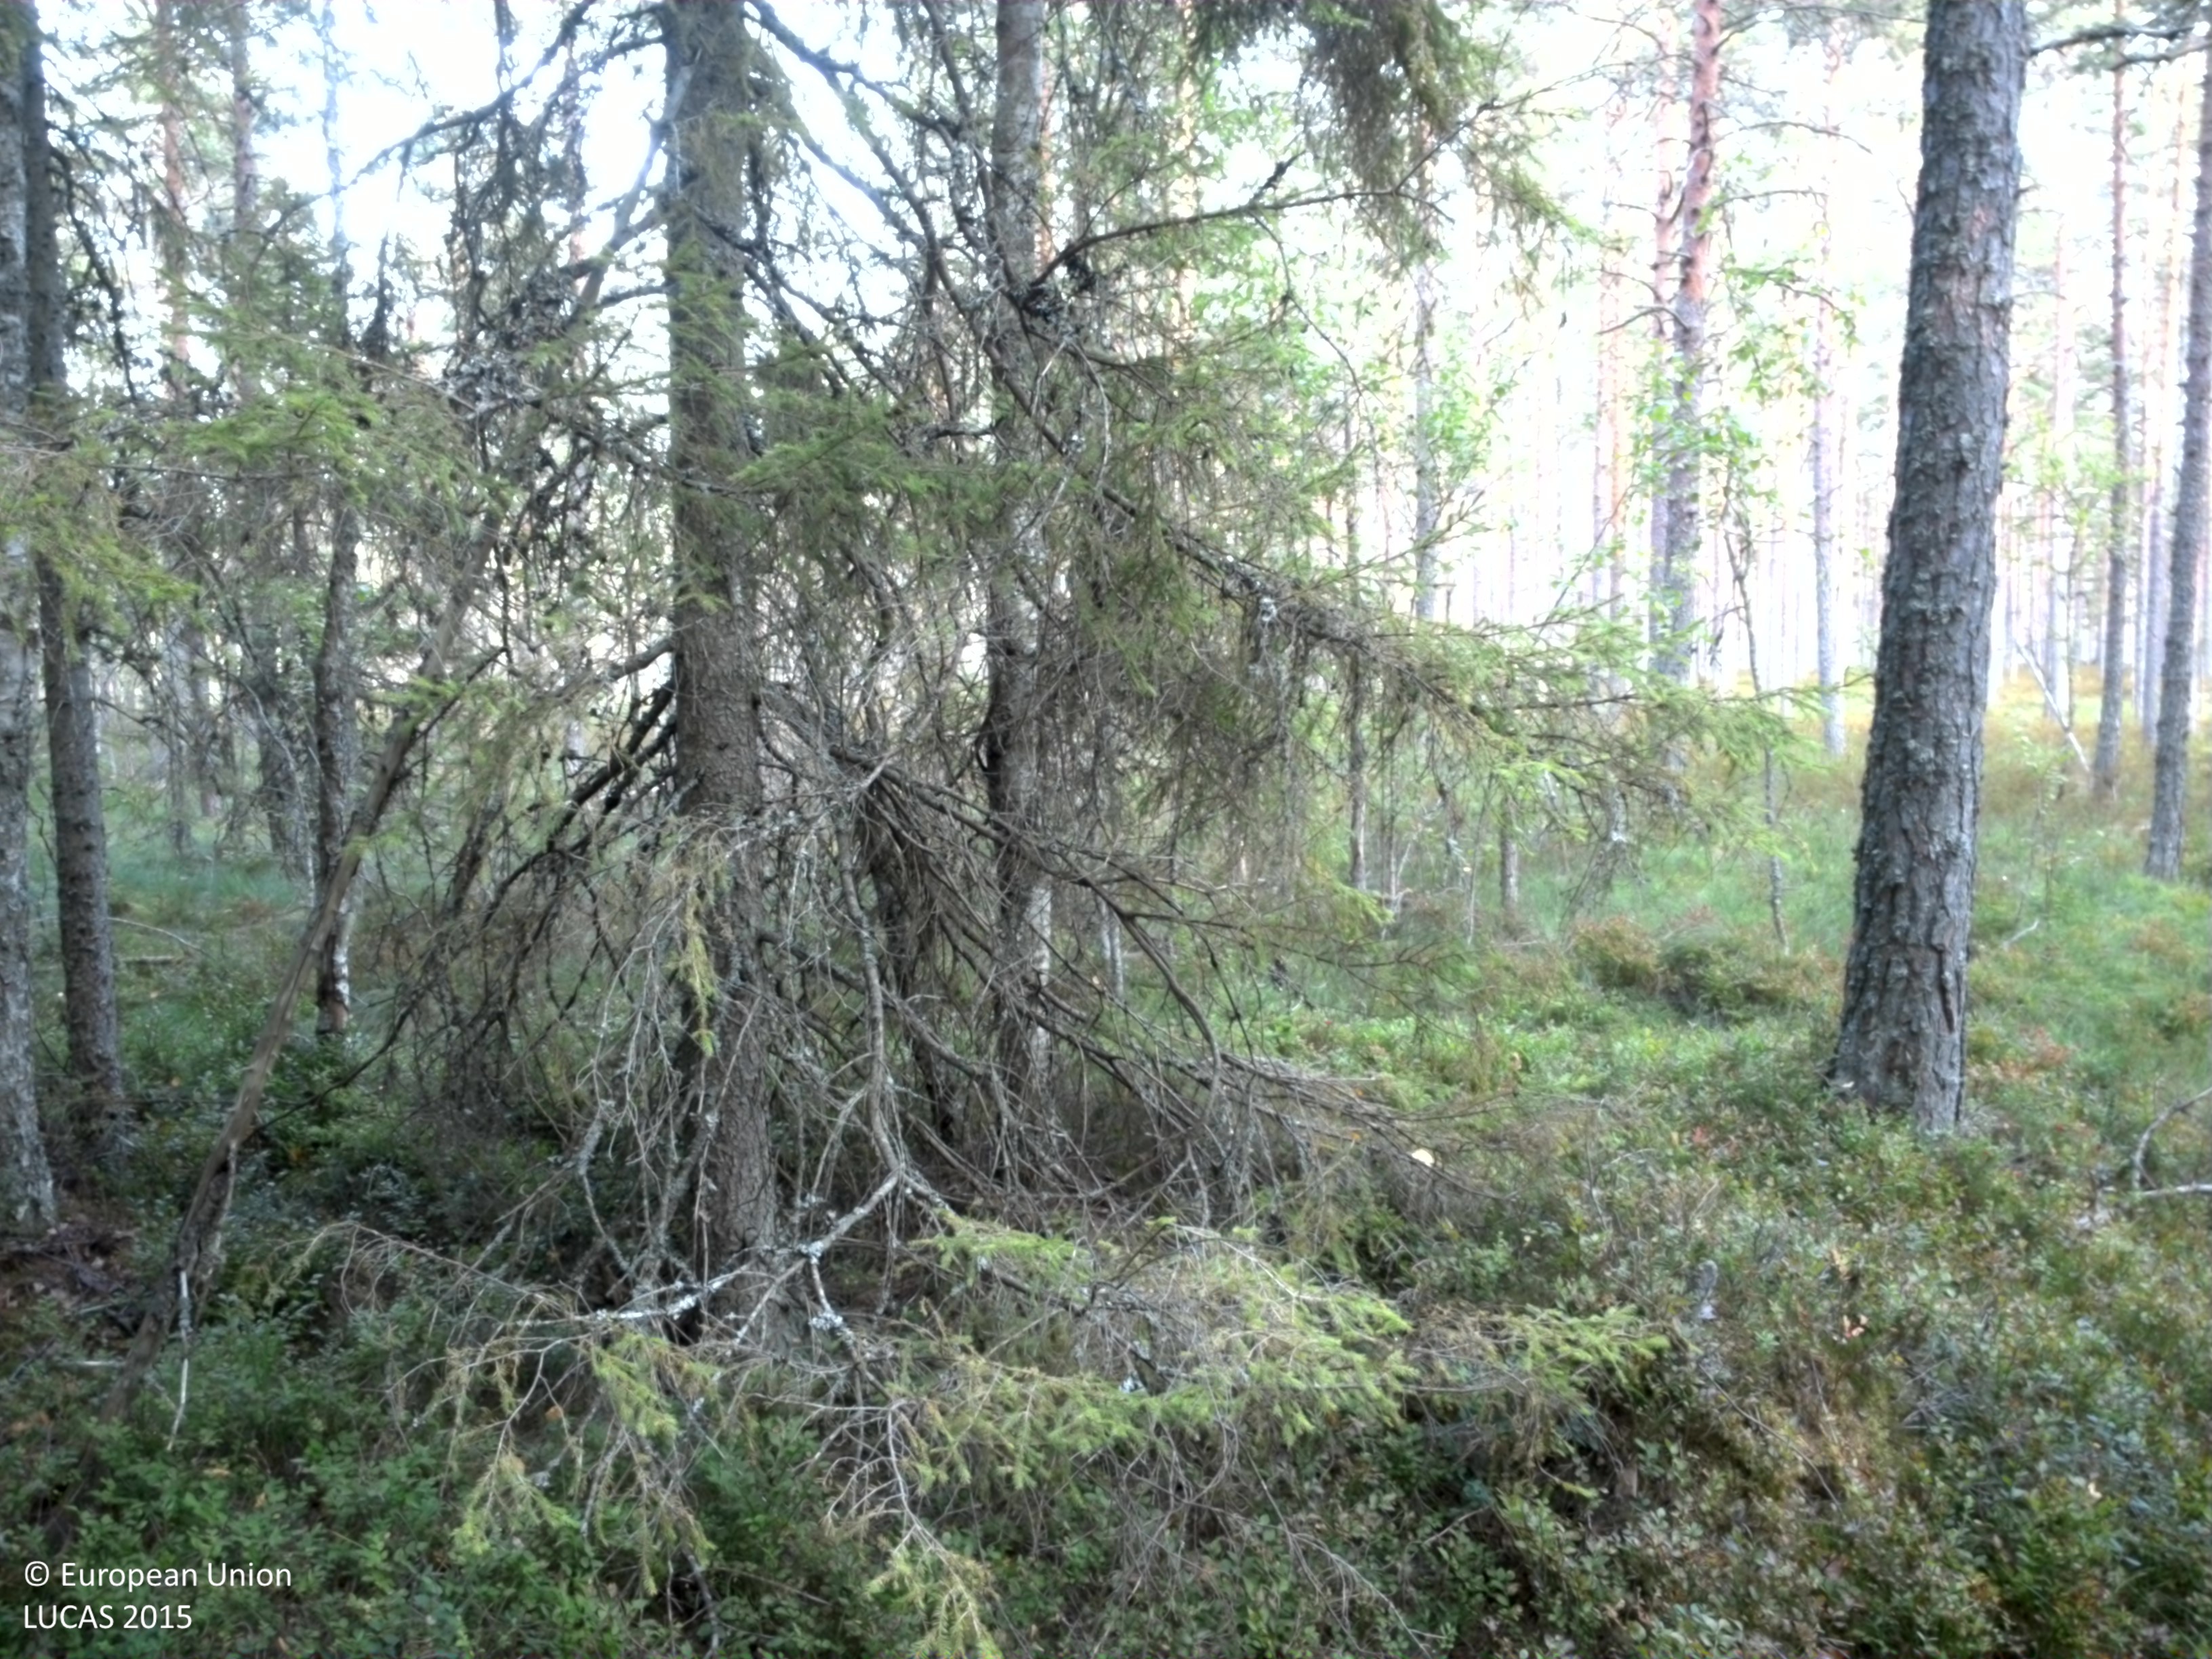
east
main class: Woodland
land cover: Other coniferous woodland
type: boreal forest
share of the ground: > 75 %
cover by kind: coniferous forest trees 60 %, broadleaved forest trees 15 %, shrubs 15 %, herbaceous plants 5 %, lichens and mosses 5 %
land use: Forestry
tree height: > 5 m
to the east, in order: Other coniferous woodland; Ditches and canals; Pine dominated coniferous woodland; Shrubland with sparse tree cover; Electric lines; Shrubland with sparse tree cover; Tracks; Shrubland with sparse tree cover; Pine dominated coniferous woodland; Pine dominated mixed woodland
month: August
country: SE
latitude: 59.8466
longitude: 15.7549
